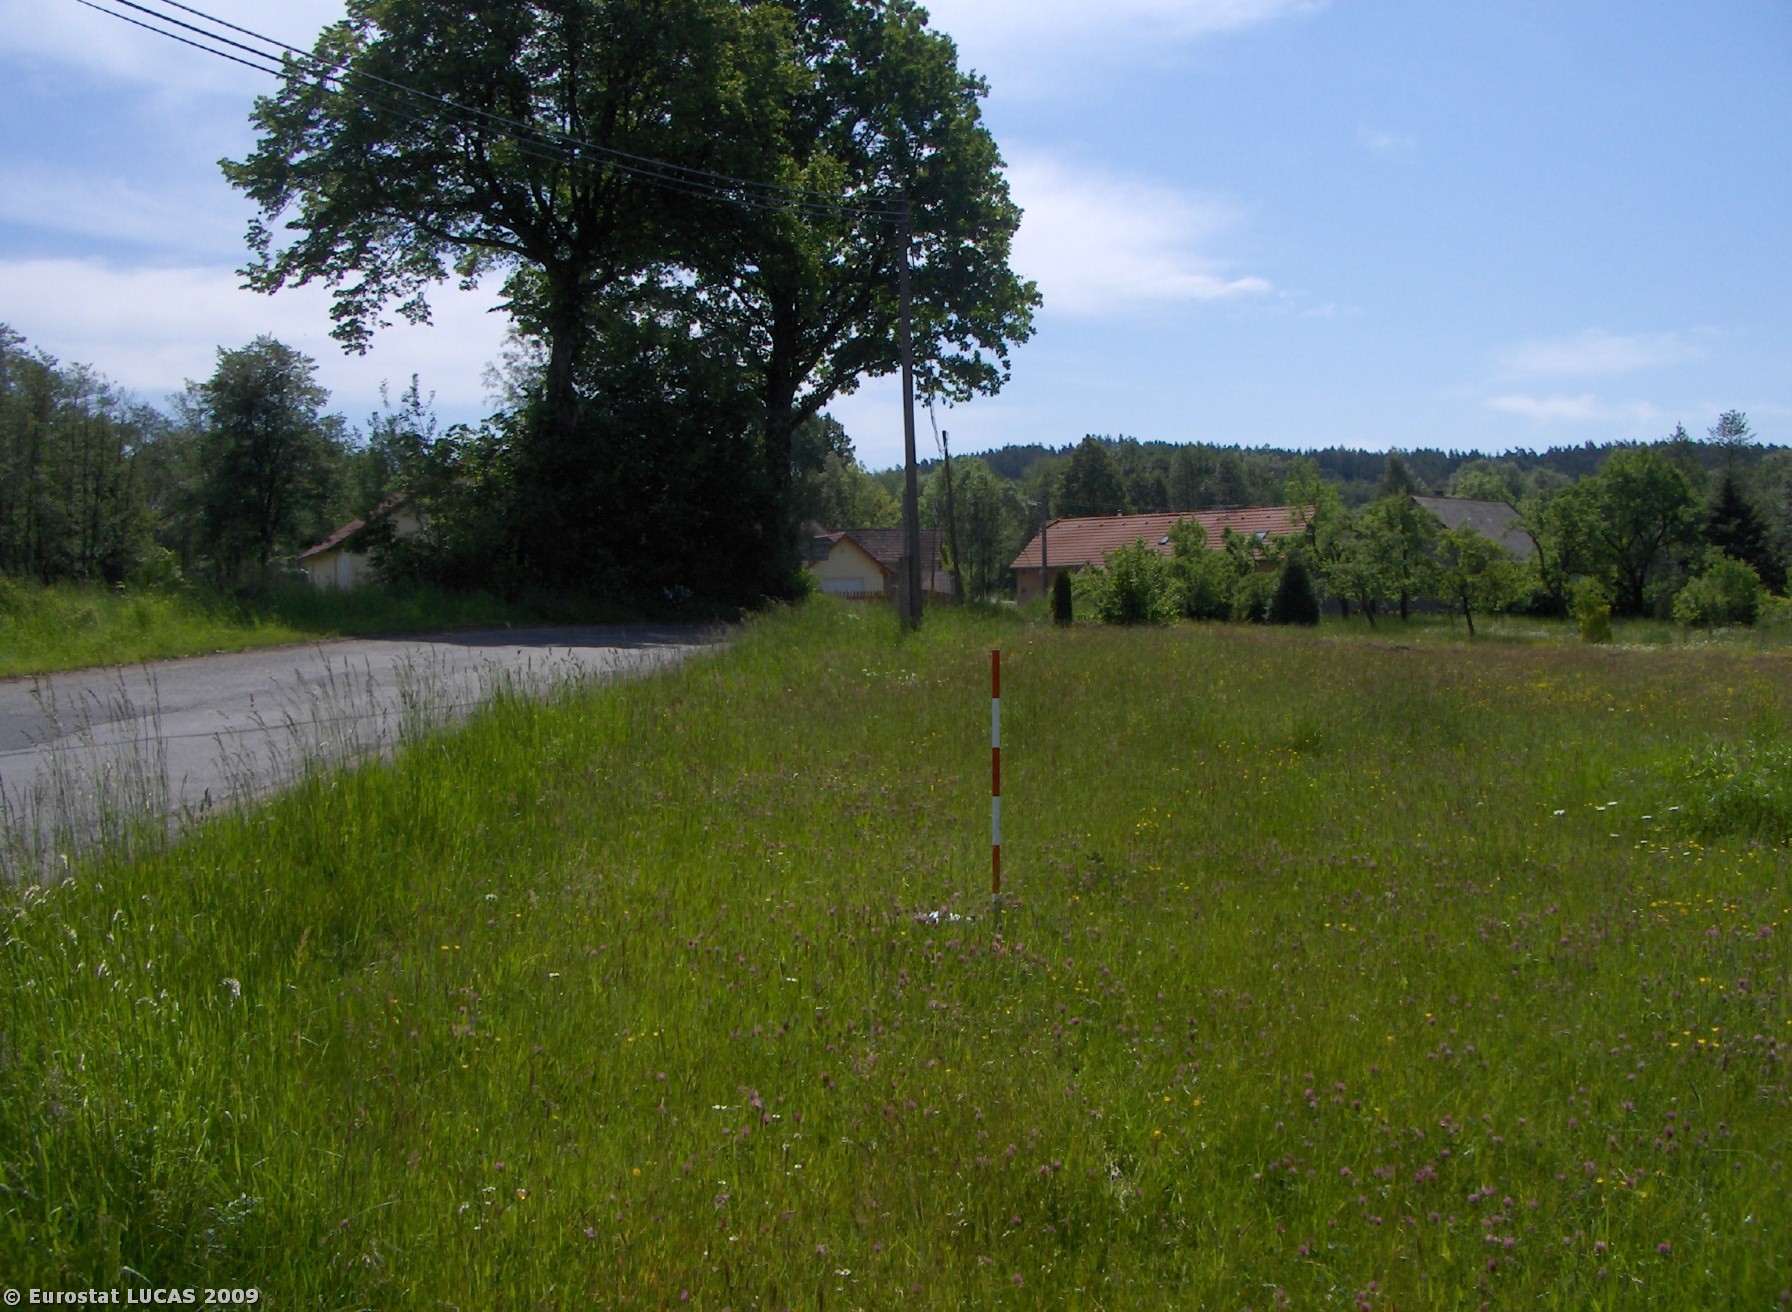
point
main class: Grassland
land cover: Grassland without tree/shrub cover
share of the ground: > 75 %
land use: Agriculture (excluding fallow land and kitchen gardens)
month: May
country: CZ
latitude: 49.5607
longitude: 14.3562
